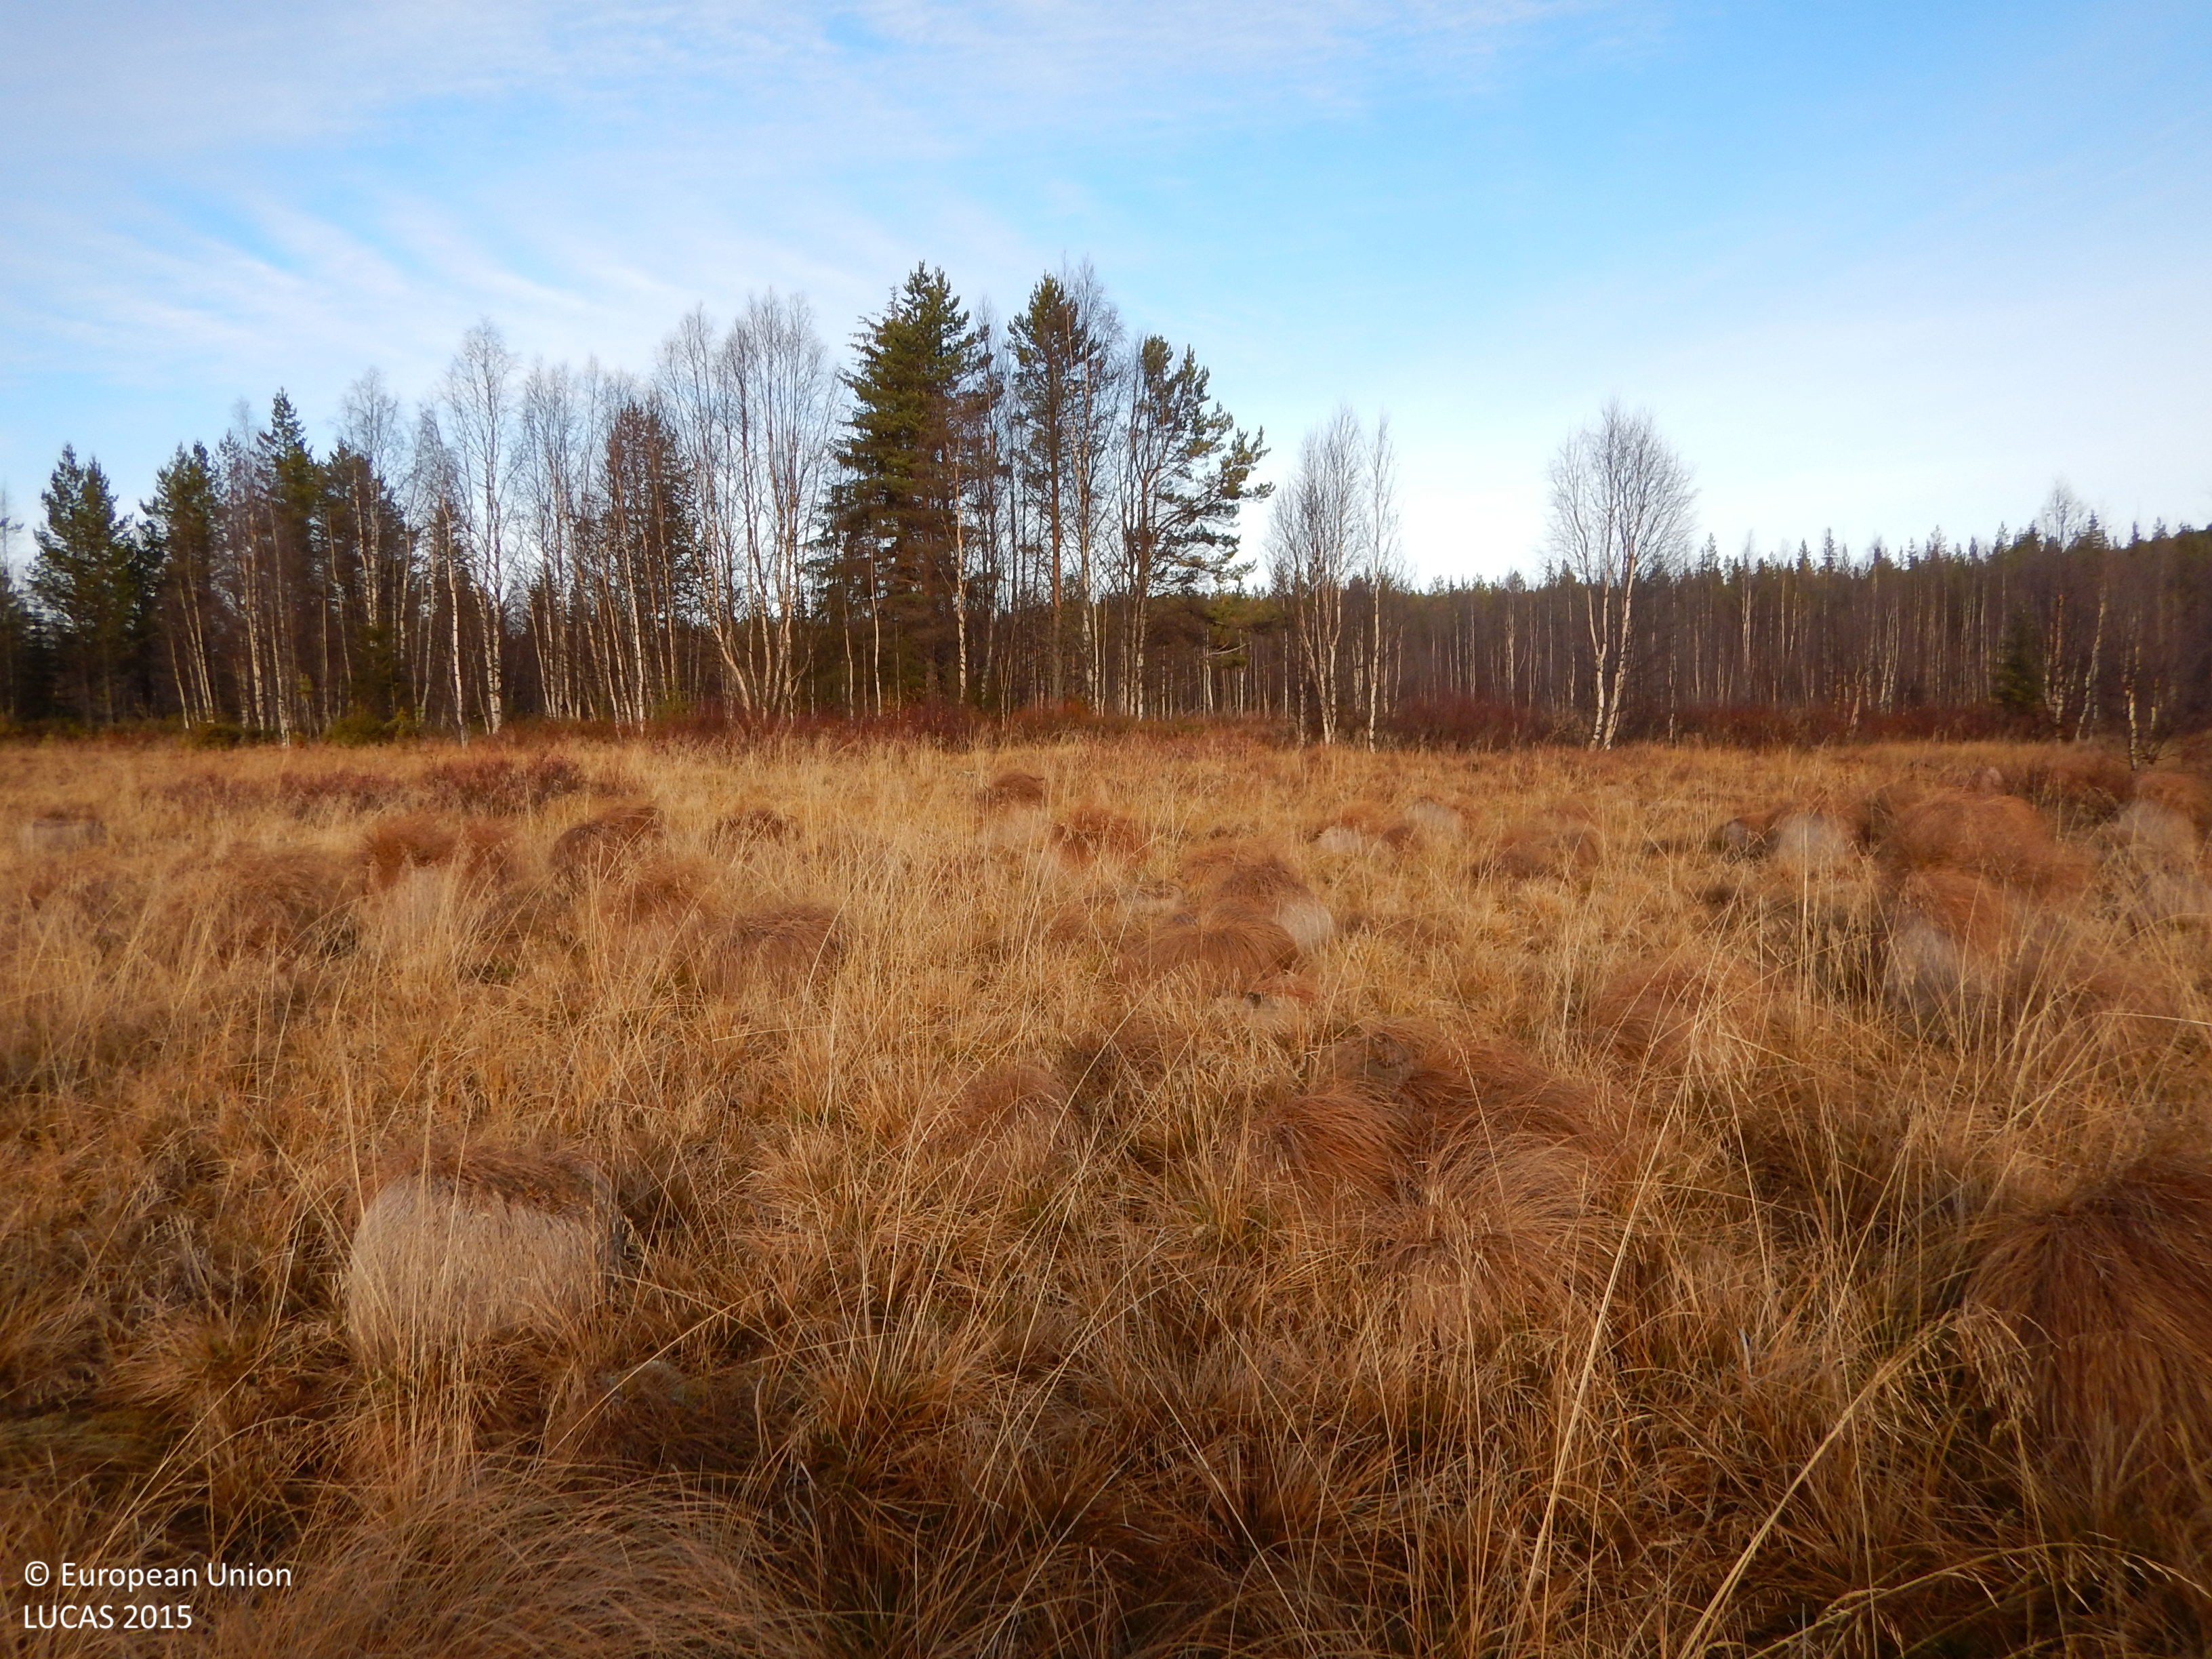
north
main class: Grassland
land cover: Grassland without tree/shrub cover
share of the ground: > 75 %
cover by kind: herbaceous plants 80 %, lichens and mosses 20 %
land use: Abandoned areas
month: October
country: SE
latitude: 65.3353
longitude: 20.0817
